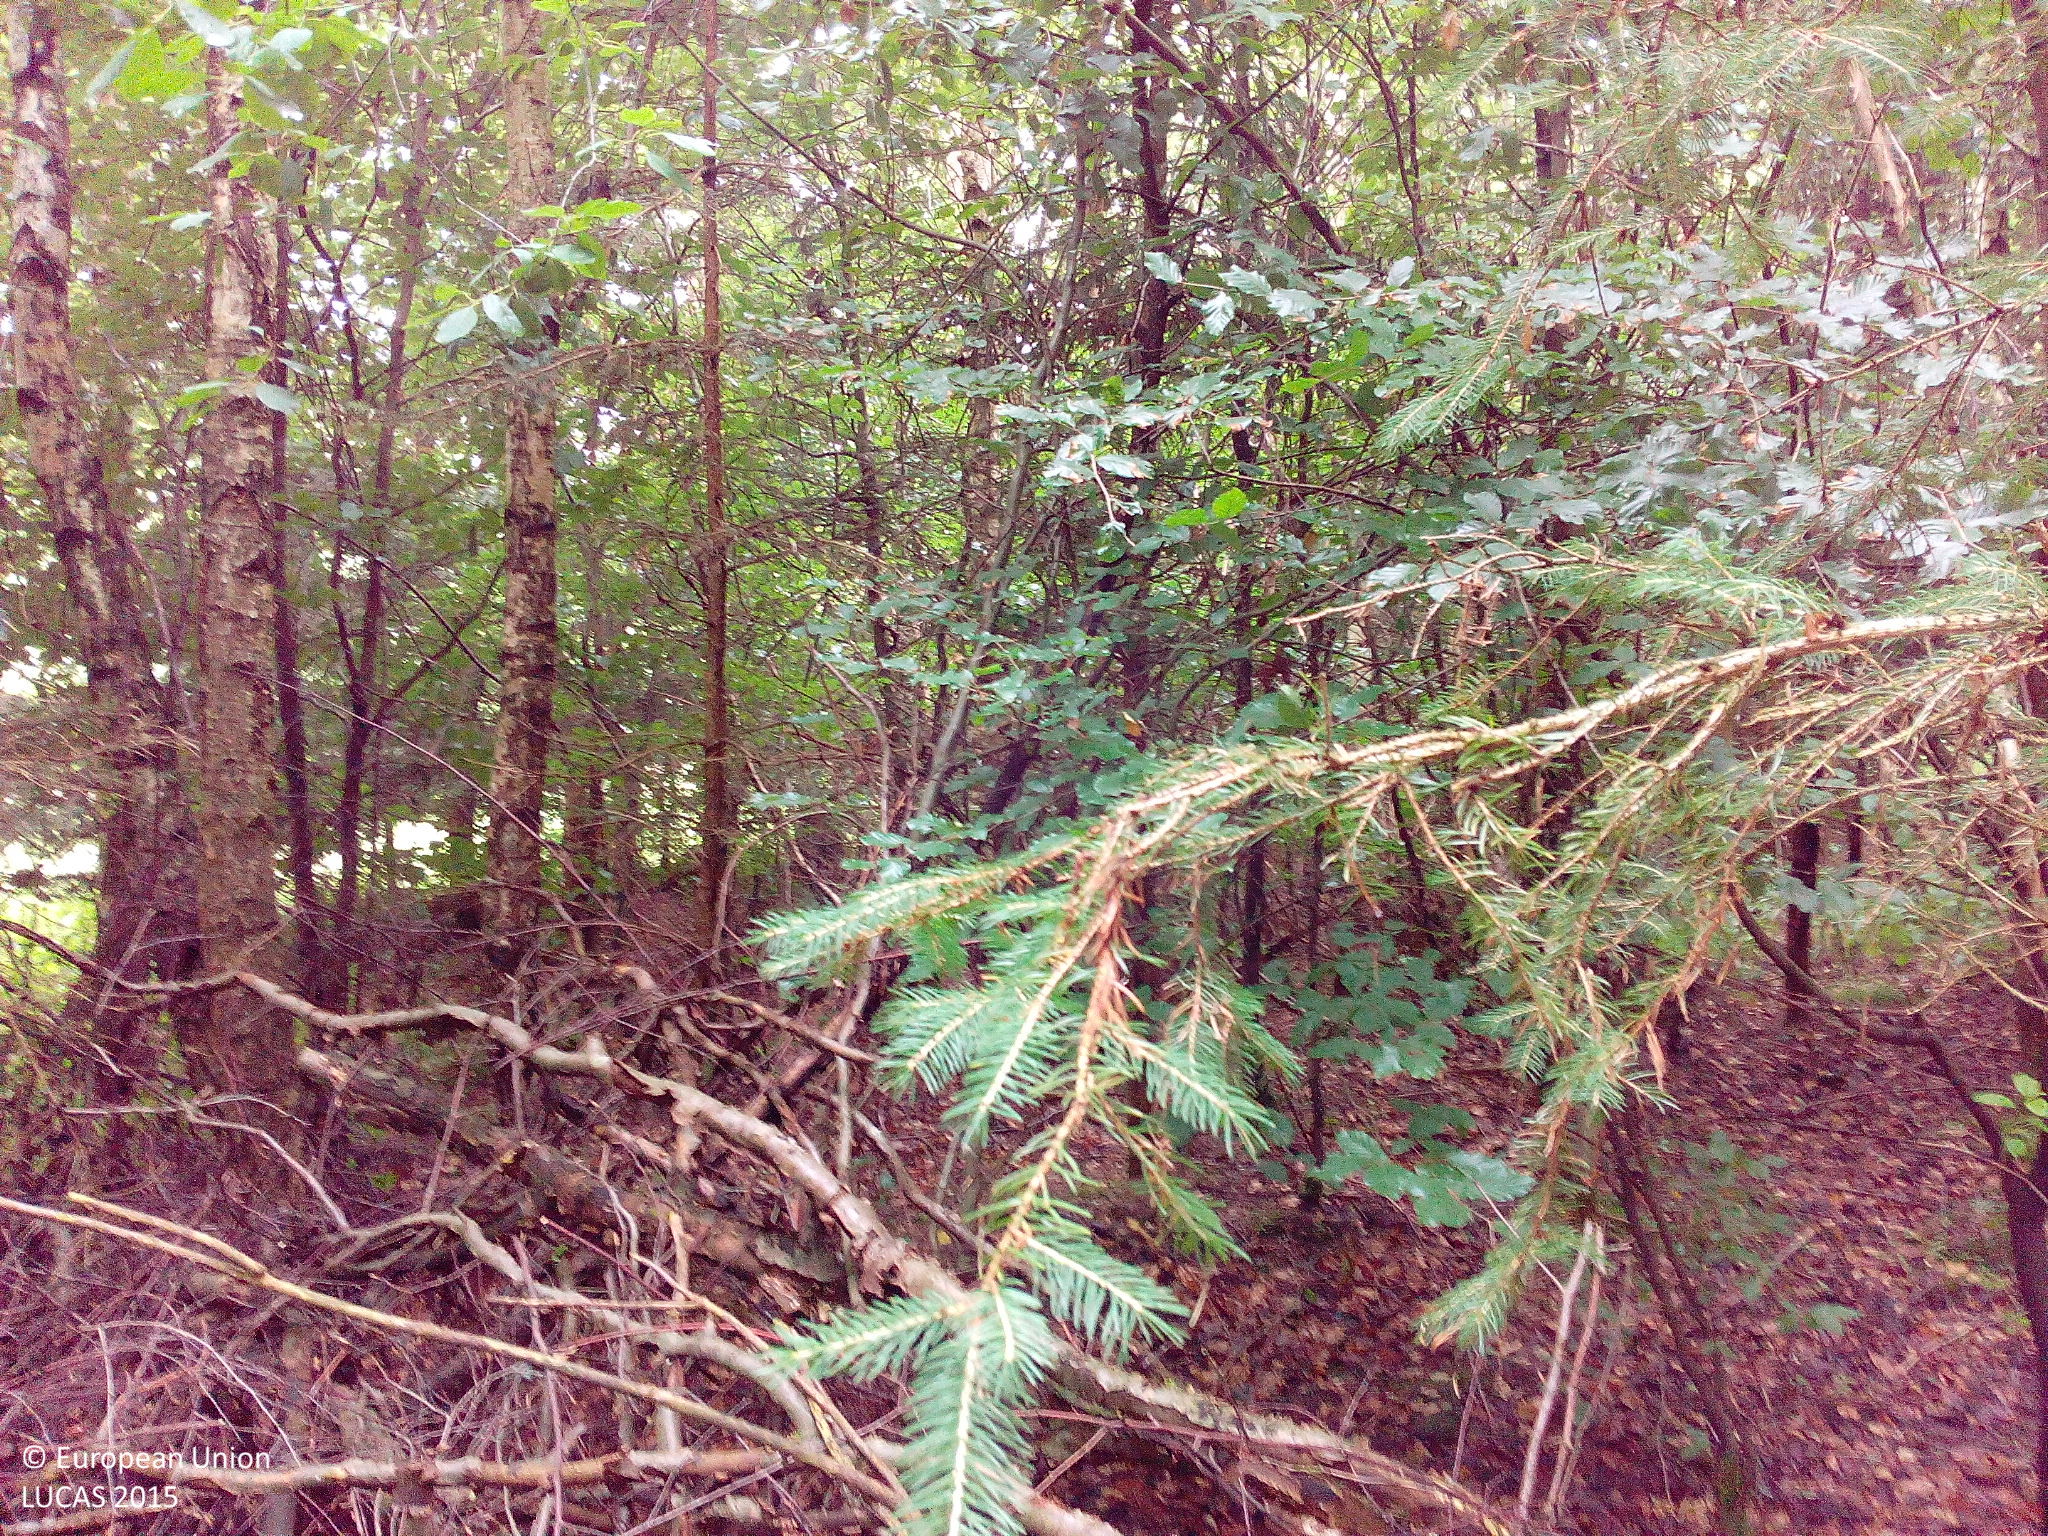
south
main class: Woodland
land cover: Spruce dominated mixed woodland
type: hemiboreal forest and nemoral coniferous forest and mixed broadleaved-coniferous forest
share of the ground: > 75 %
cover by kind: broadleaved forest trees 65 %, coniferous forest trees 25 %, herbaceous plants 10 %
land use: Forestry
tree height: > 5 m
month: July
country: DE
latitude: 50.8674
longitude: 9.9290
